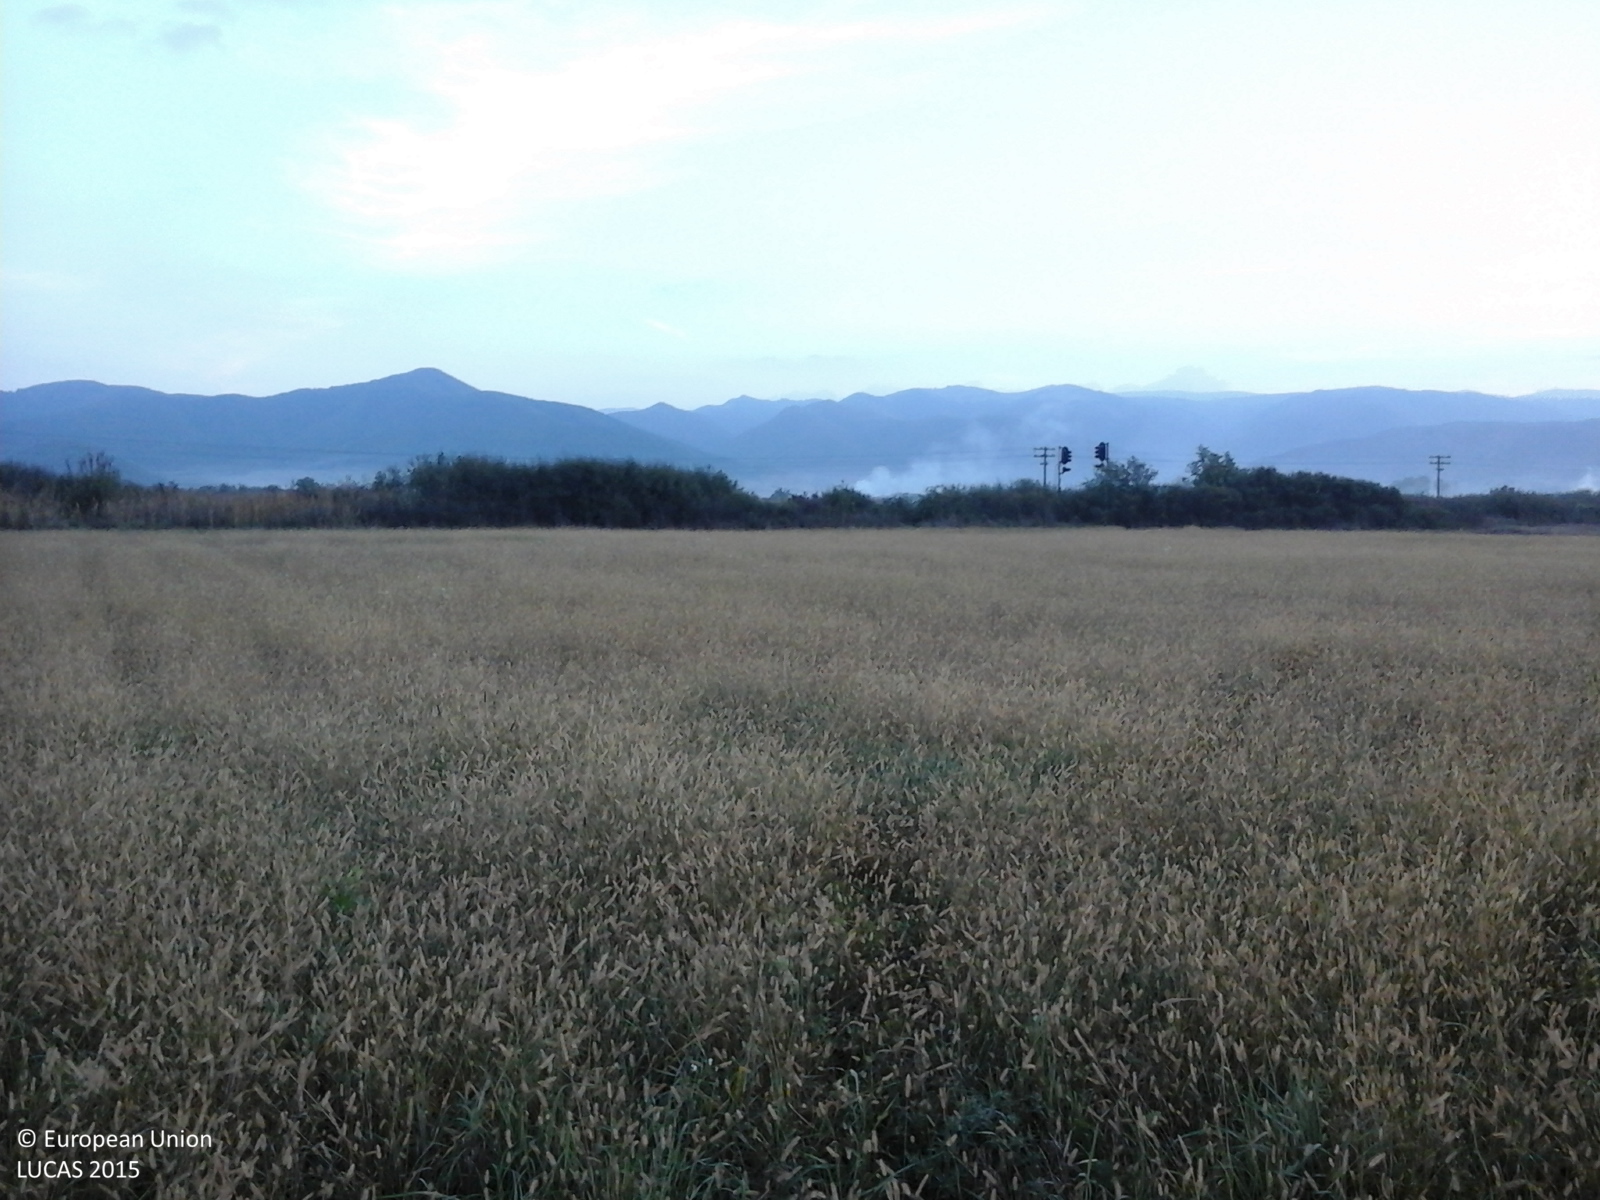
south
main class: Grassland
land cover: Grassland without tree/shrub cover
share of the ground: > 75 %
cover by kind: herbaceous plants 100 %
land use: Agriculture (excluding fallow land and kitchen gardens)
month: October
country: RO
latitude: 45.7722
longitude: 23.9990
